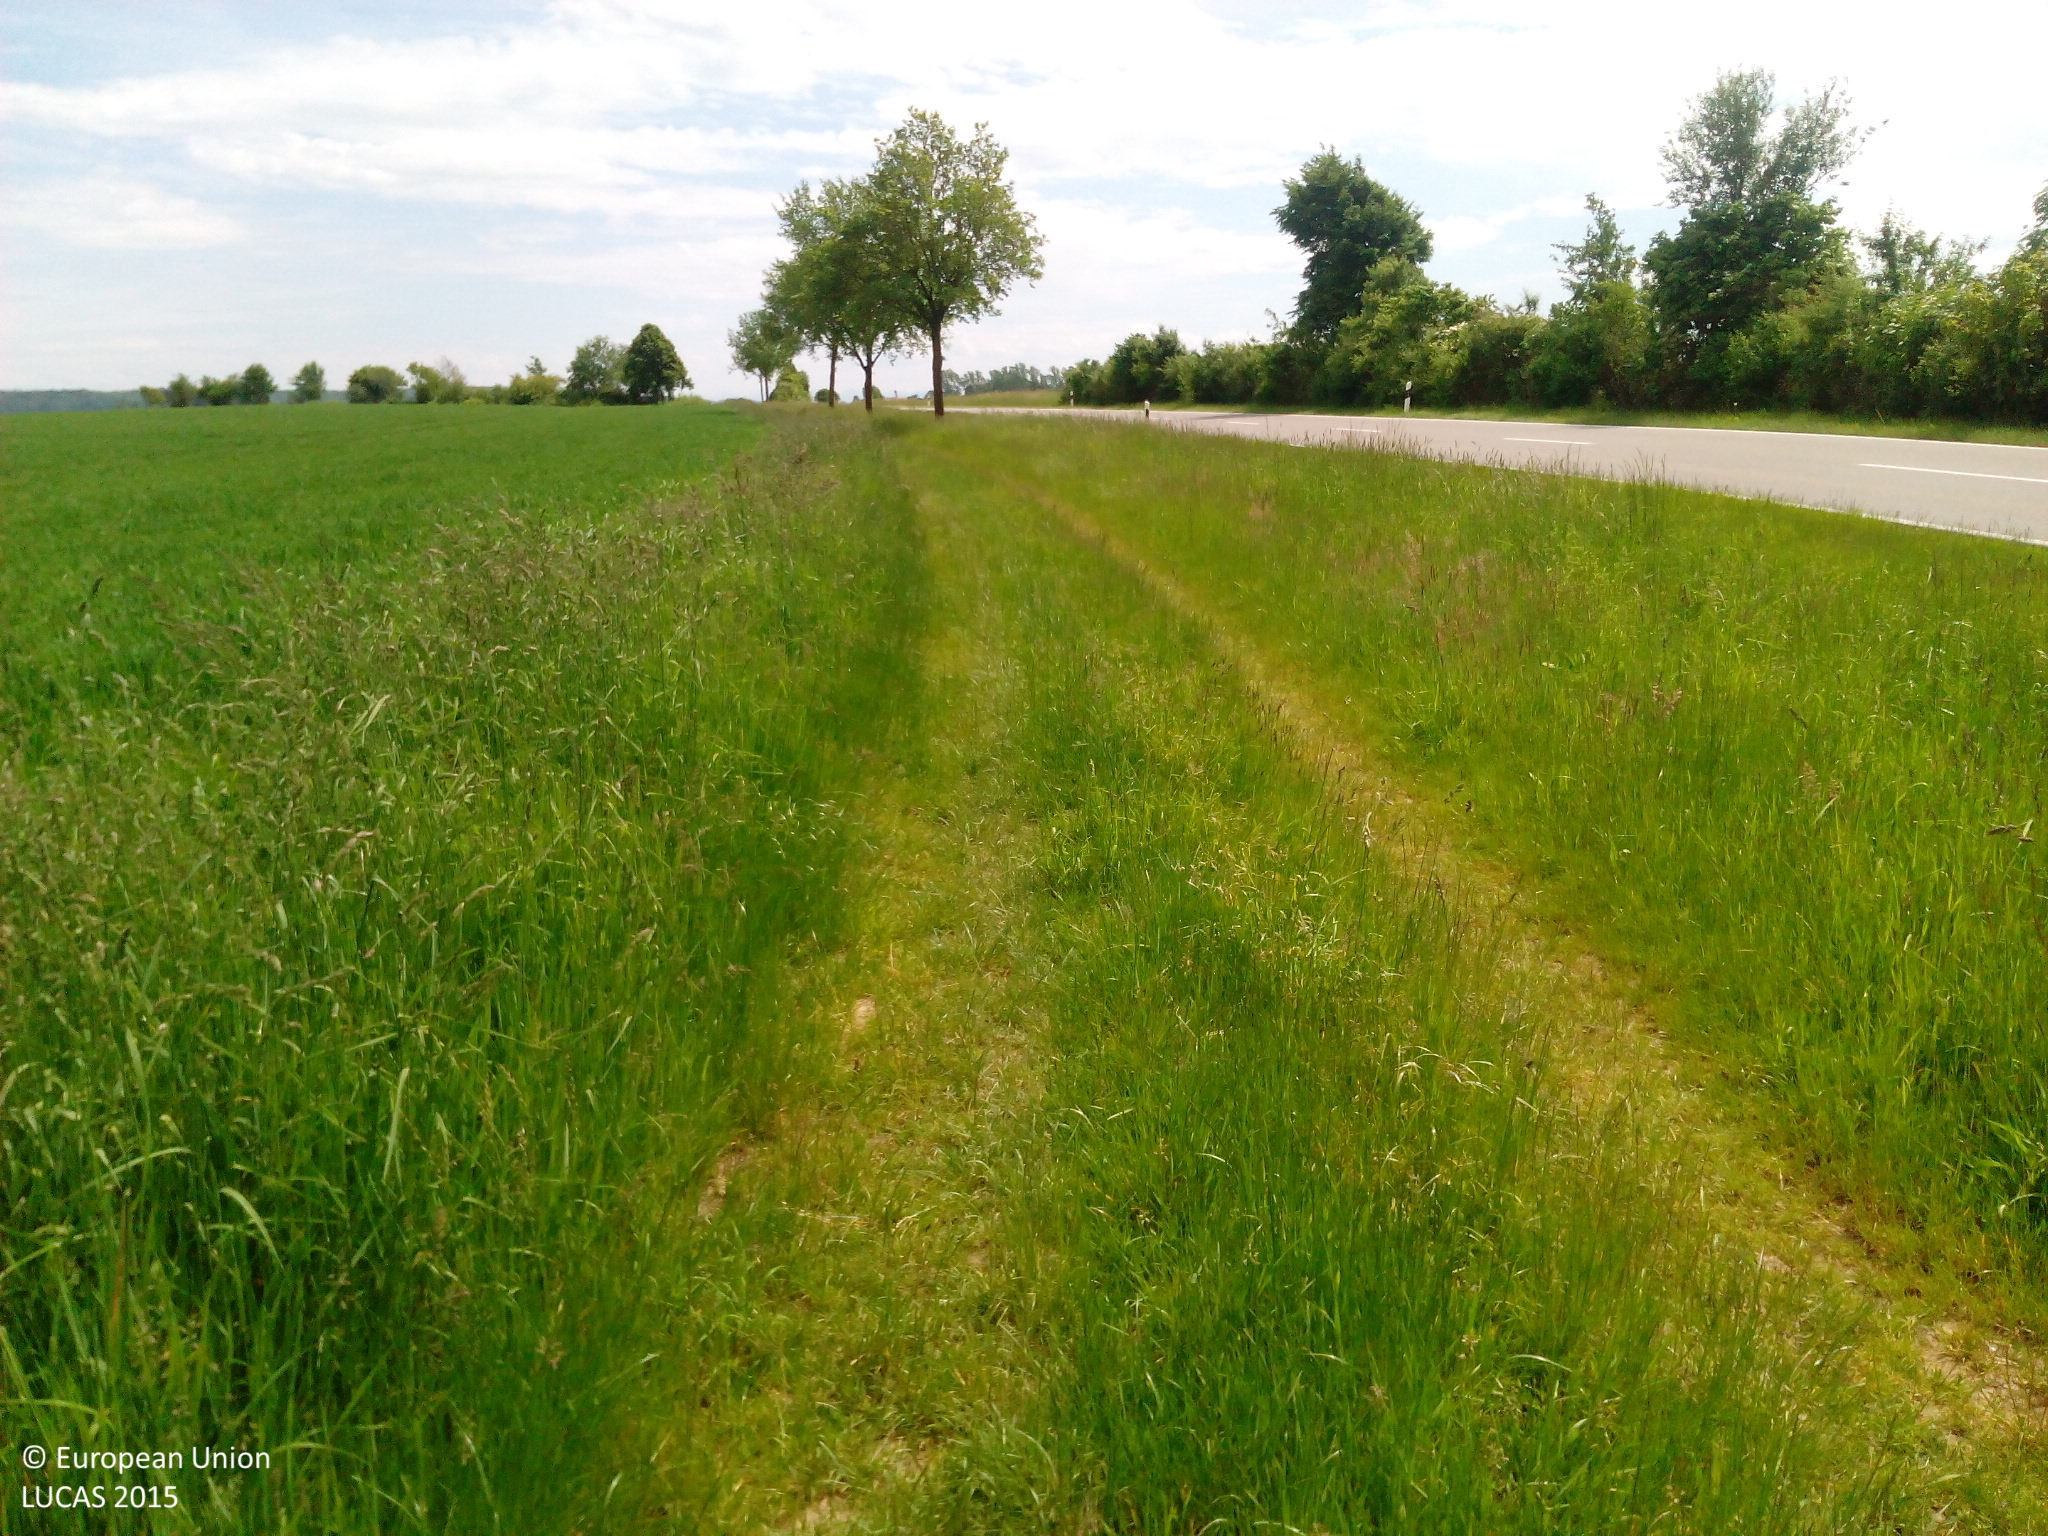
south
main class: Cropland
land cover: Rye
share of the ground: > 75 %
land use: Agriculture (excluding fallow land and kitchen gardens)
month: May
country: DE
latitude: 48.1692
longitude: 10.2553
